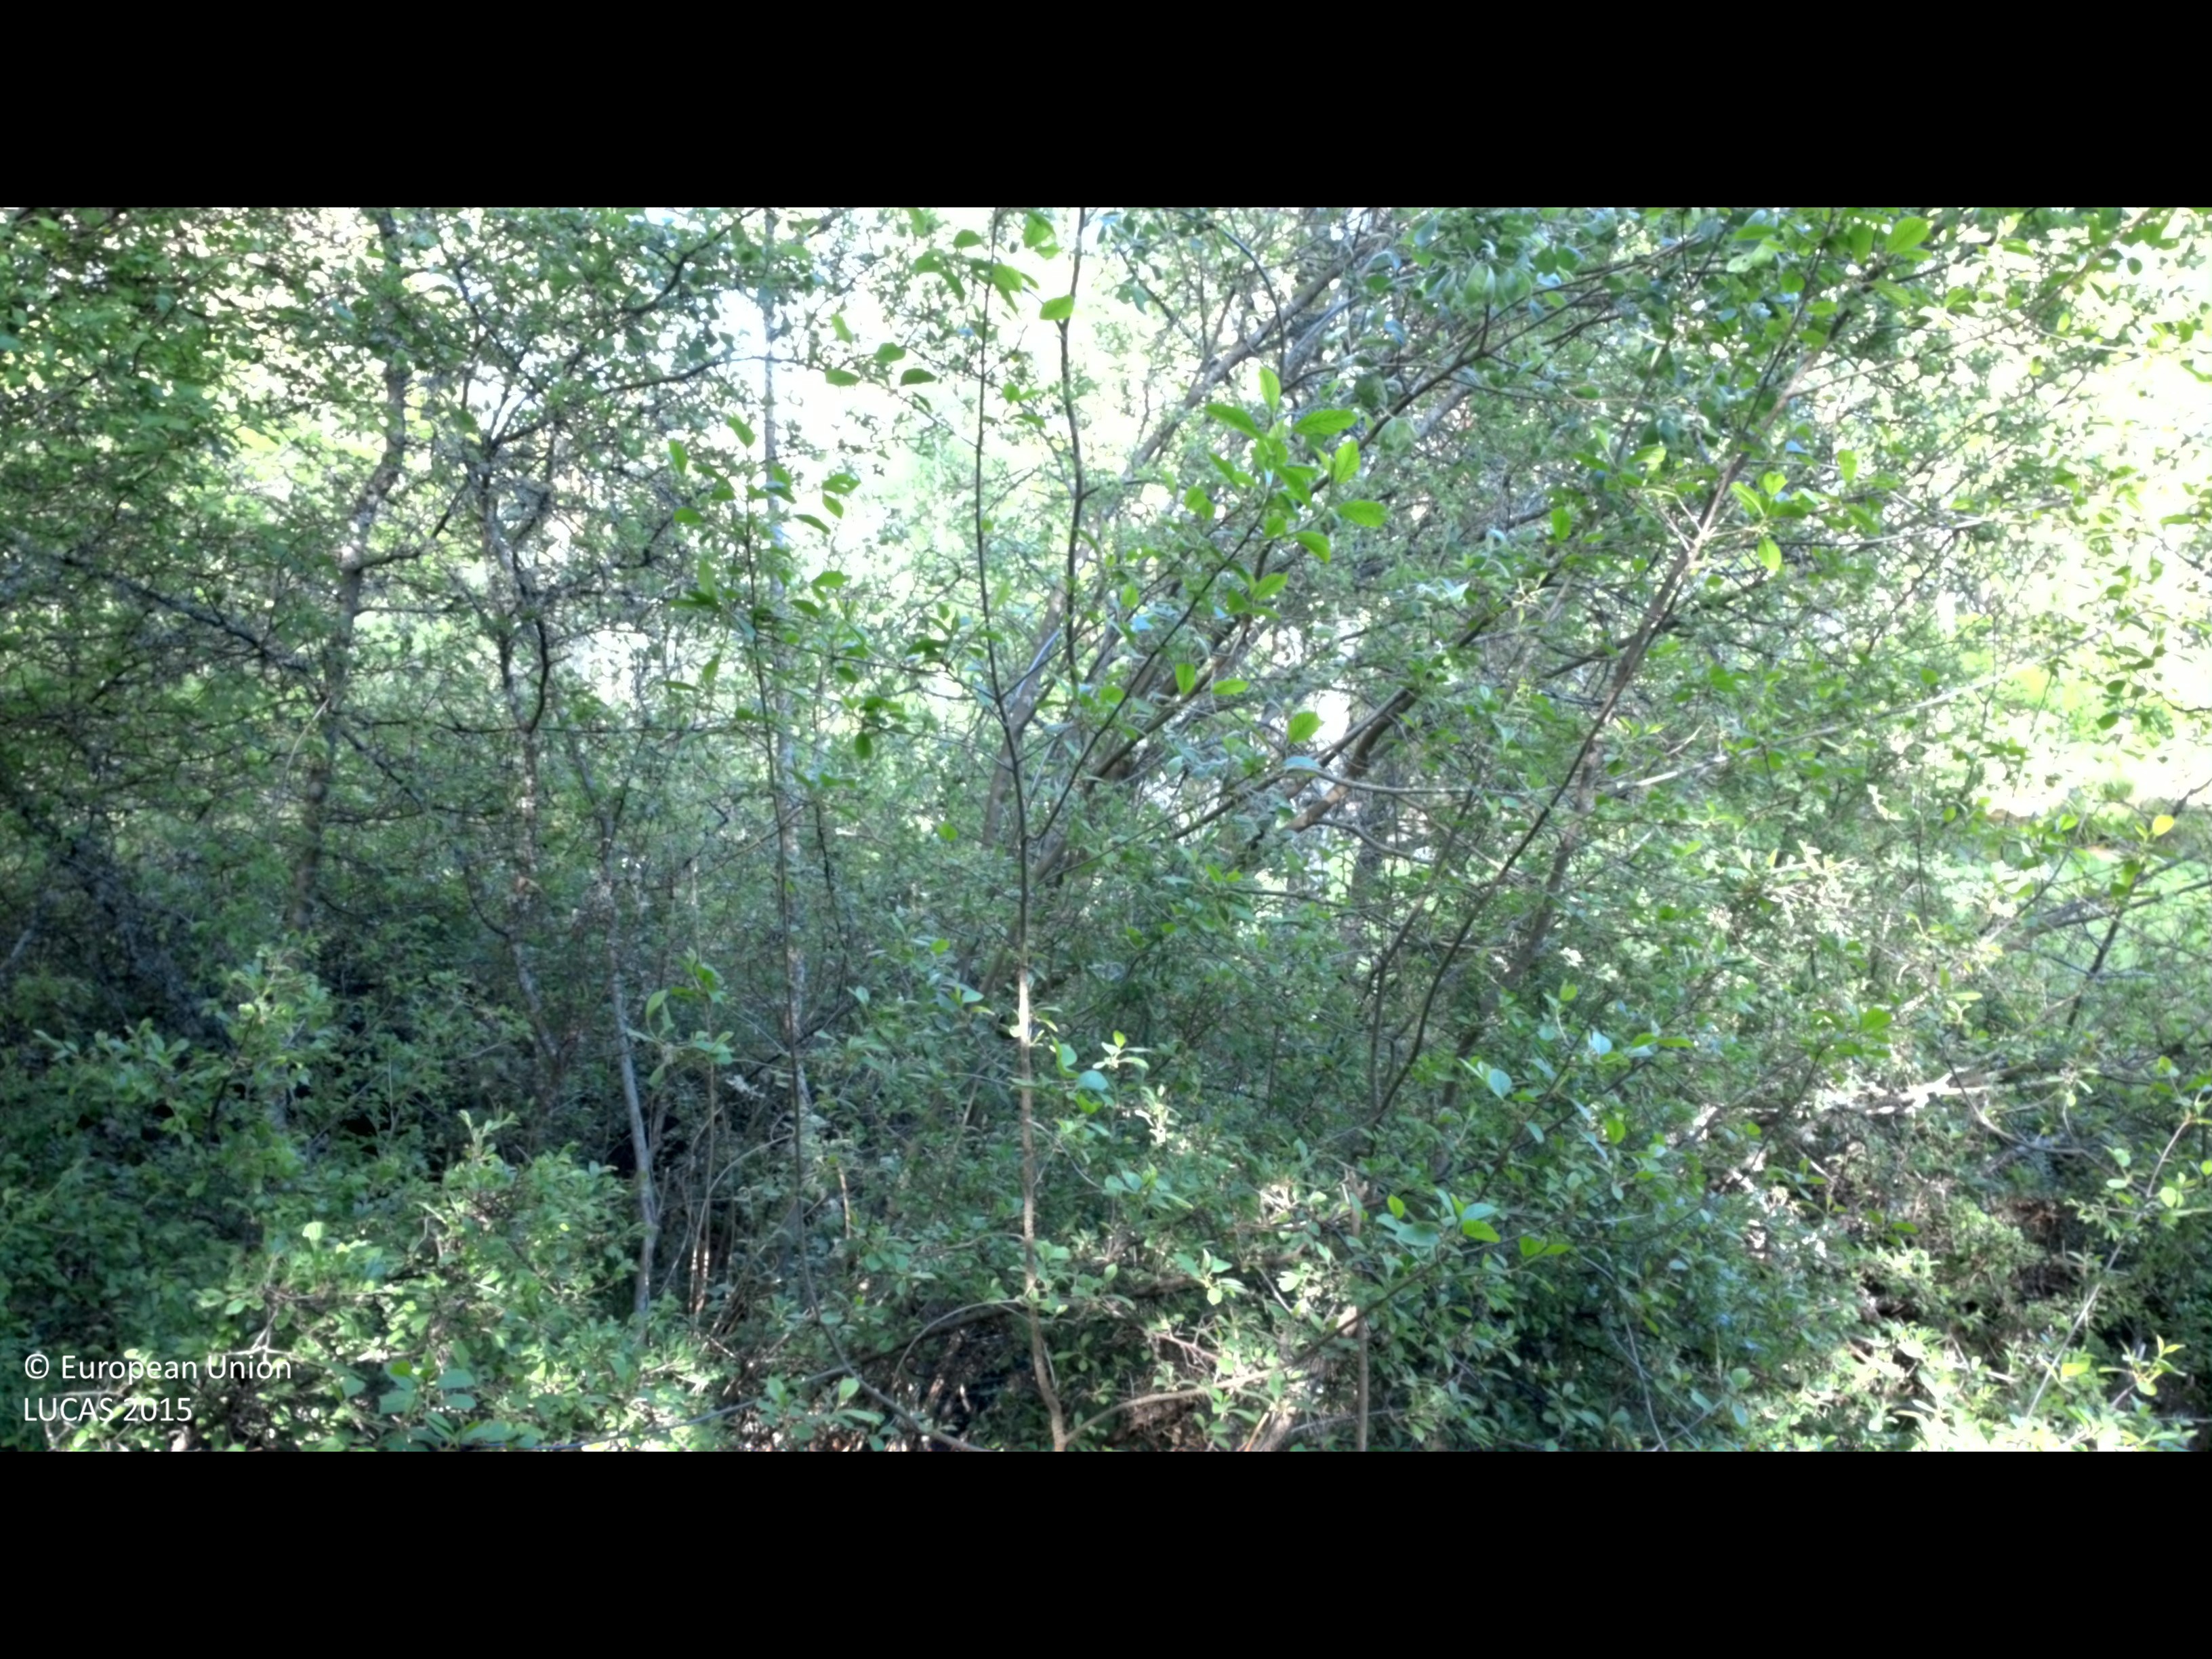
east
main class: Woodland
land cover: Broadleaved woodland
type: hemiboreal forest and nemoral coniferous forest and mixed broadleaved-coniferous forest
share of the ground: 25 - 50 %
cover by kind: broadleaved forest trees 50 %, herbaceous plants 30 %, shrubs 20 %
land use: Agriculture (excluding fallow land and kitchen gardens)
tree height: > 5 m
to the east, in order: Broadleaved woodland; Grassland with sparse tree/shrub cover; Fences; Broadleaved woodland; Fences; Grassland with sparse tree/shrub cover; Fences; Pine dominated coniferous woodland; Fences; Paved roads, cycling and walking lanes; Fences; Broadleaved woodland; Pine dominated coniferous woodland
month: May
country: SE
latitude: 57.2884
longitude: 16.4536
